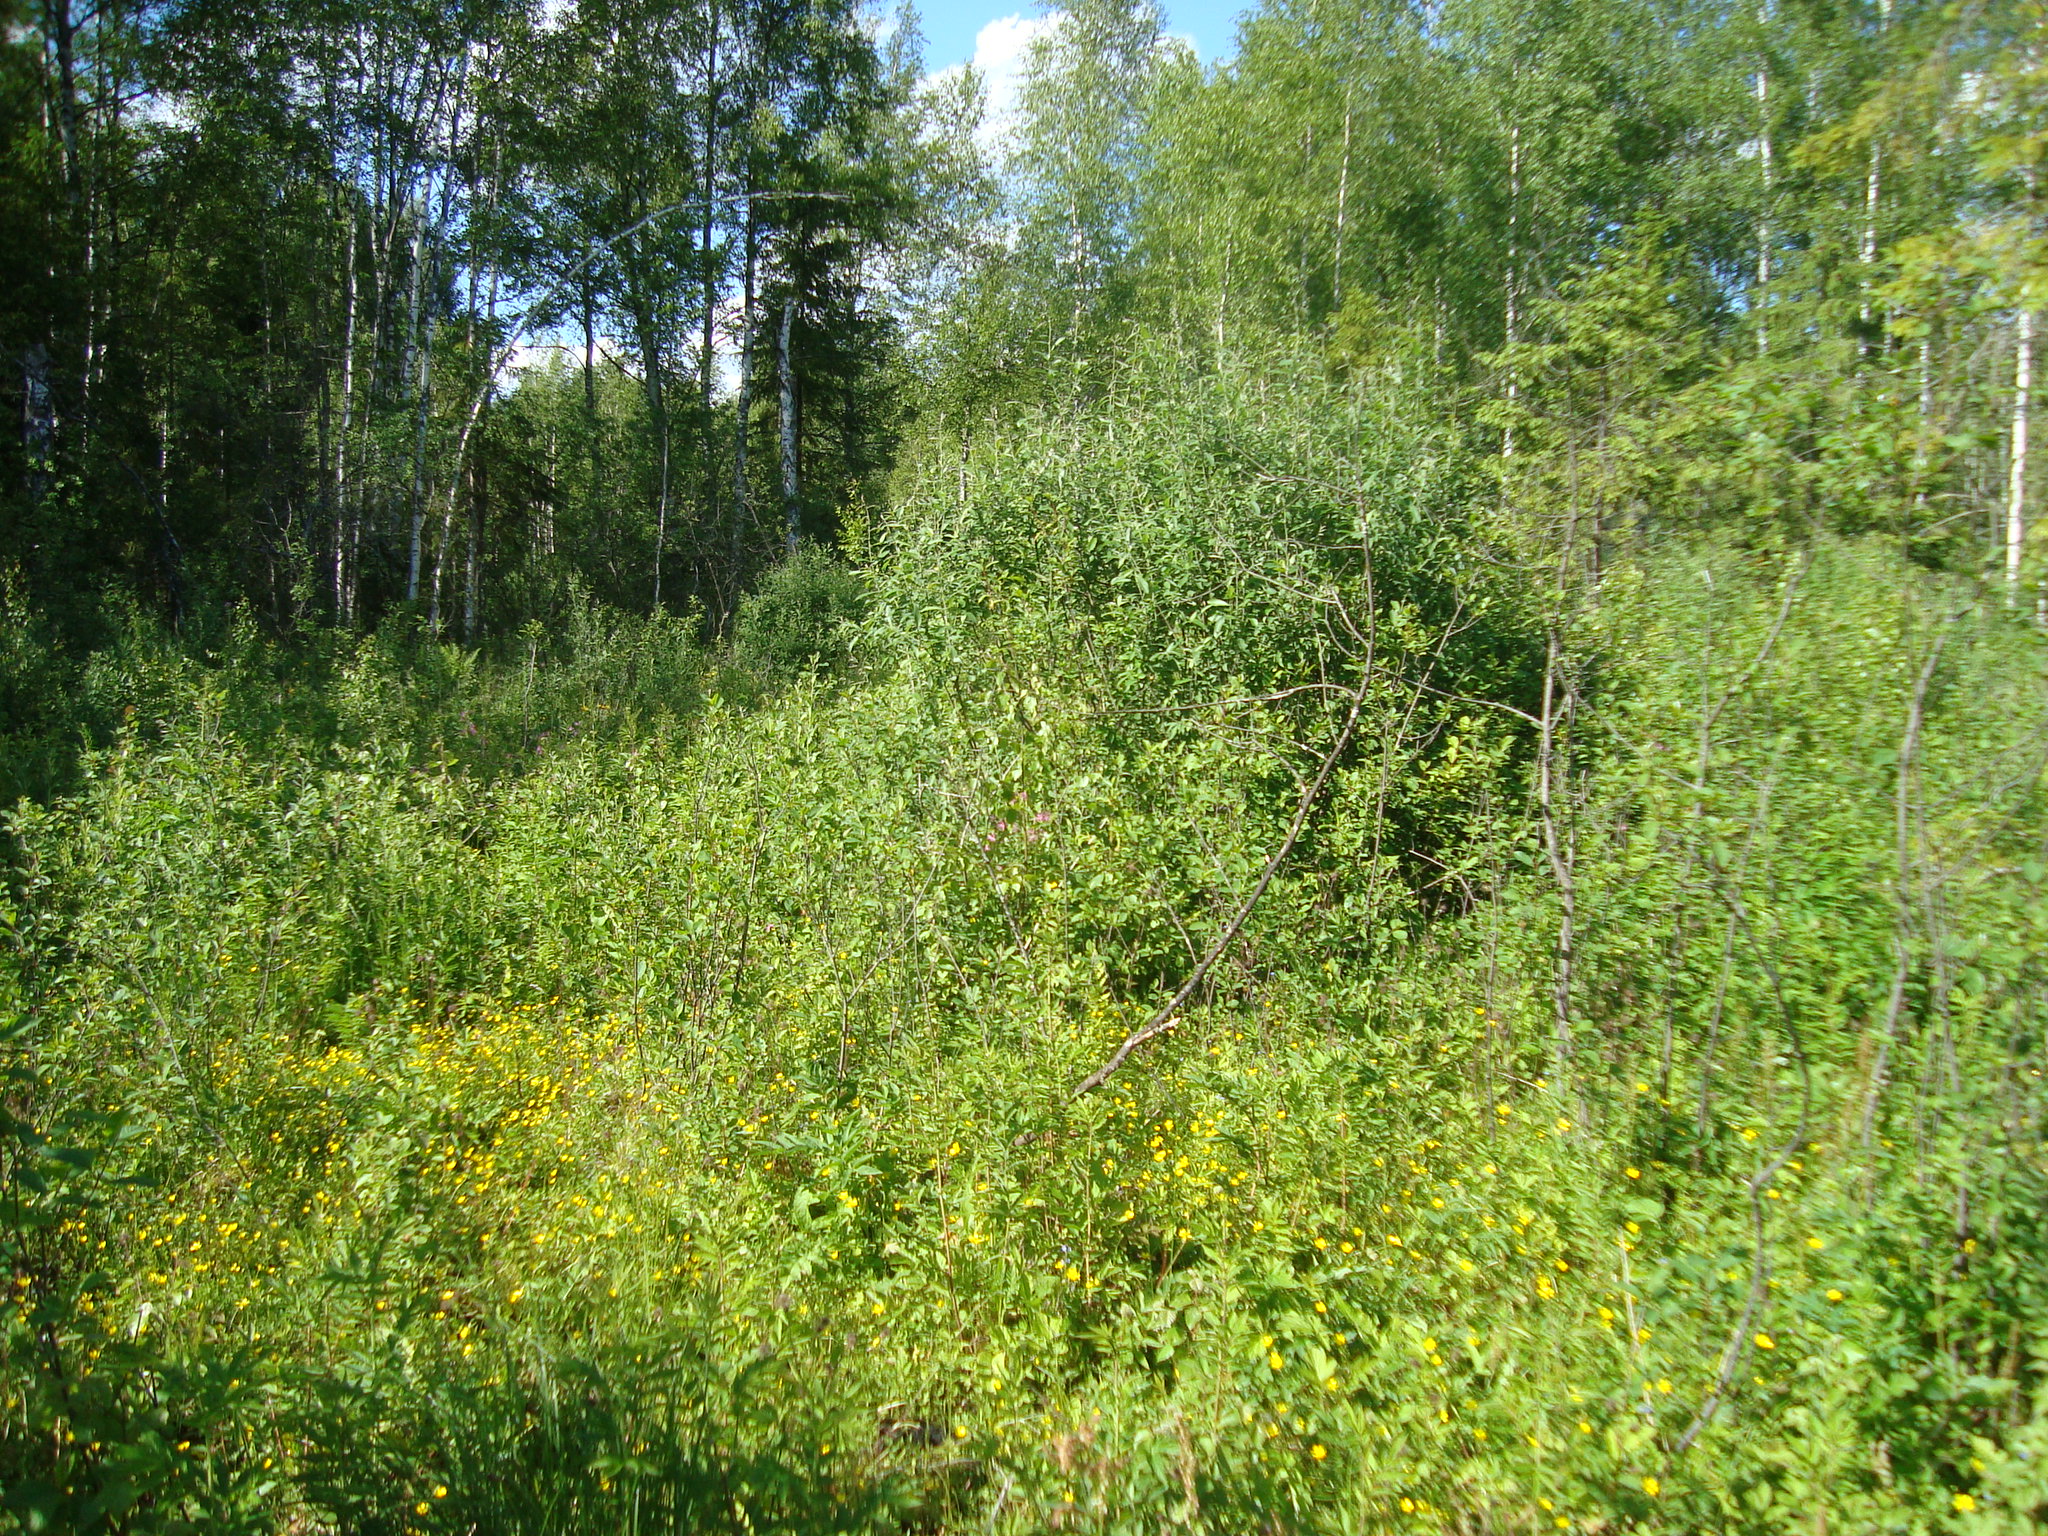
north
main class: Woodland
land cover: Spruce dominated mixed woodland
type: hemiboreal forest and nemoral coniferous forest and mixed broadleaved-coniferous forest
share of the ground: > 75 %
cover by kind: broadleaved forest trees 50 %, coniferous forest trees 30 %, shrubs 15 %, herbaceous plants 5 %
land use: Forestry
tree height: < 5 m
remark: Clear cut
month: June
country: LV
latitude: 56.6585
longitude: 25.7377
